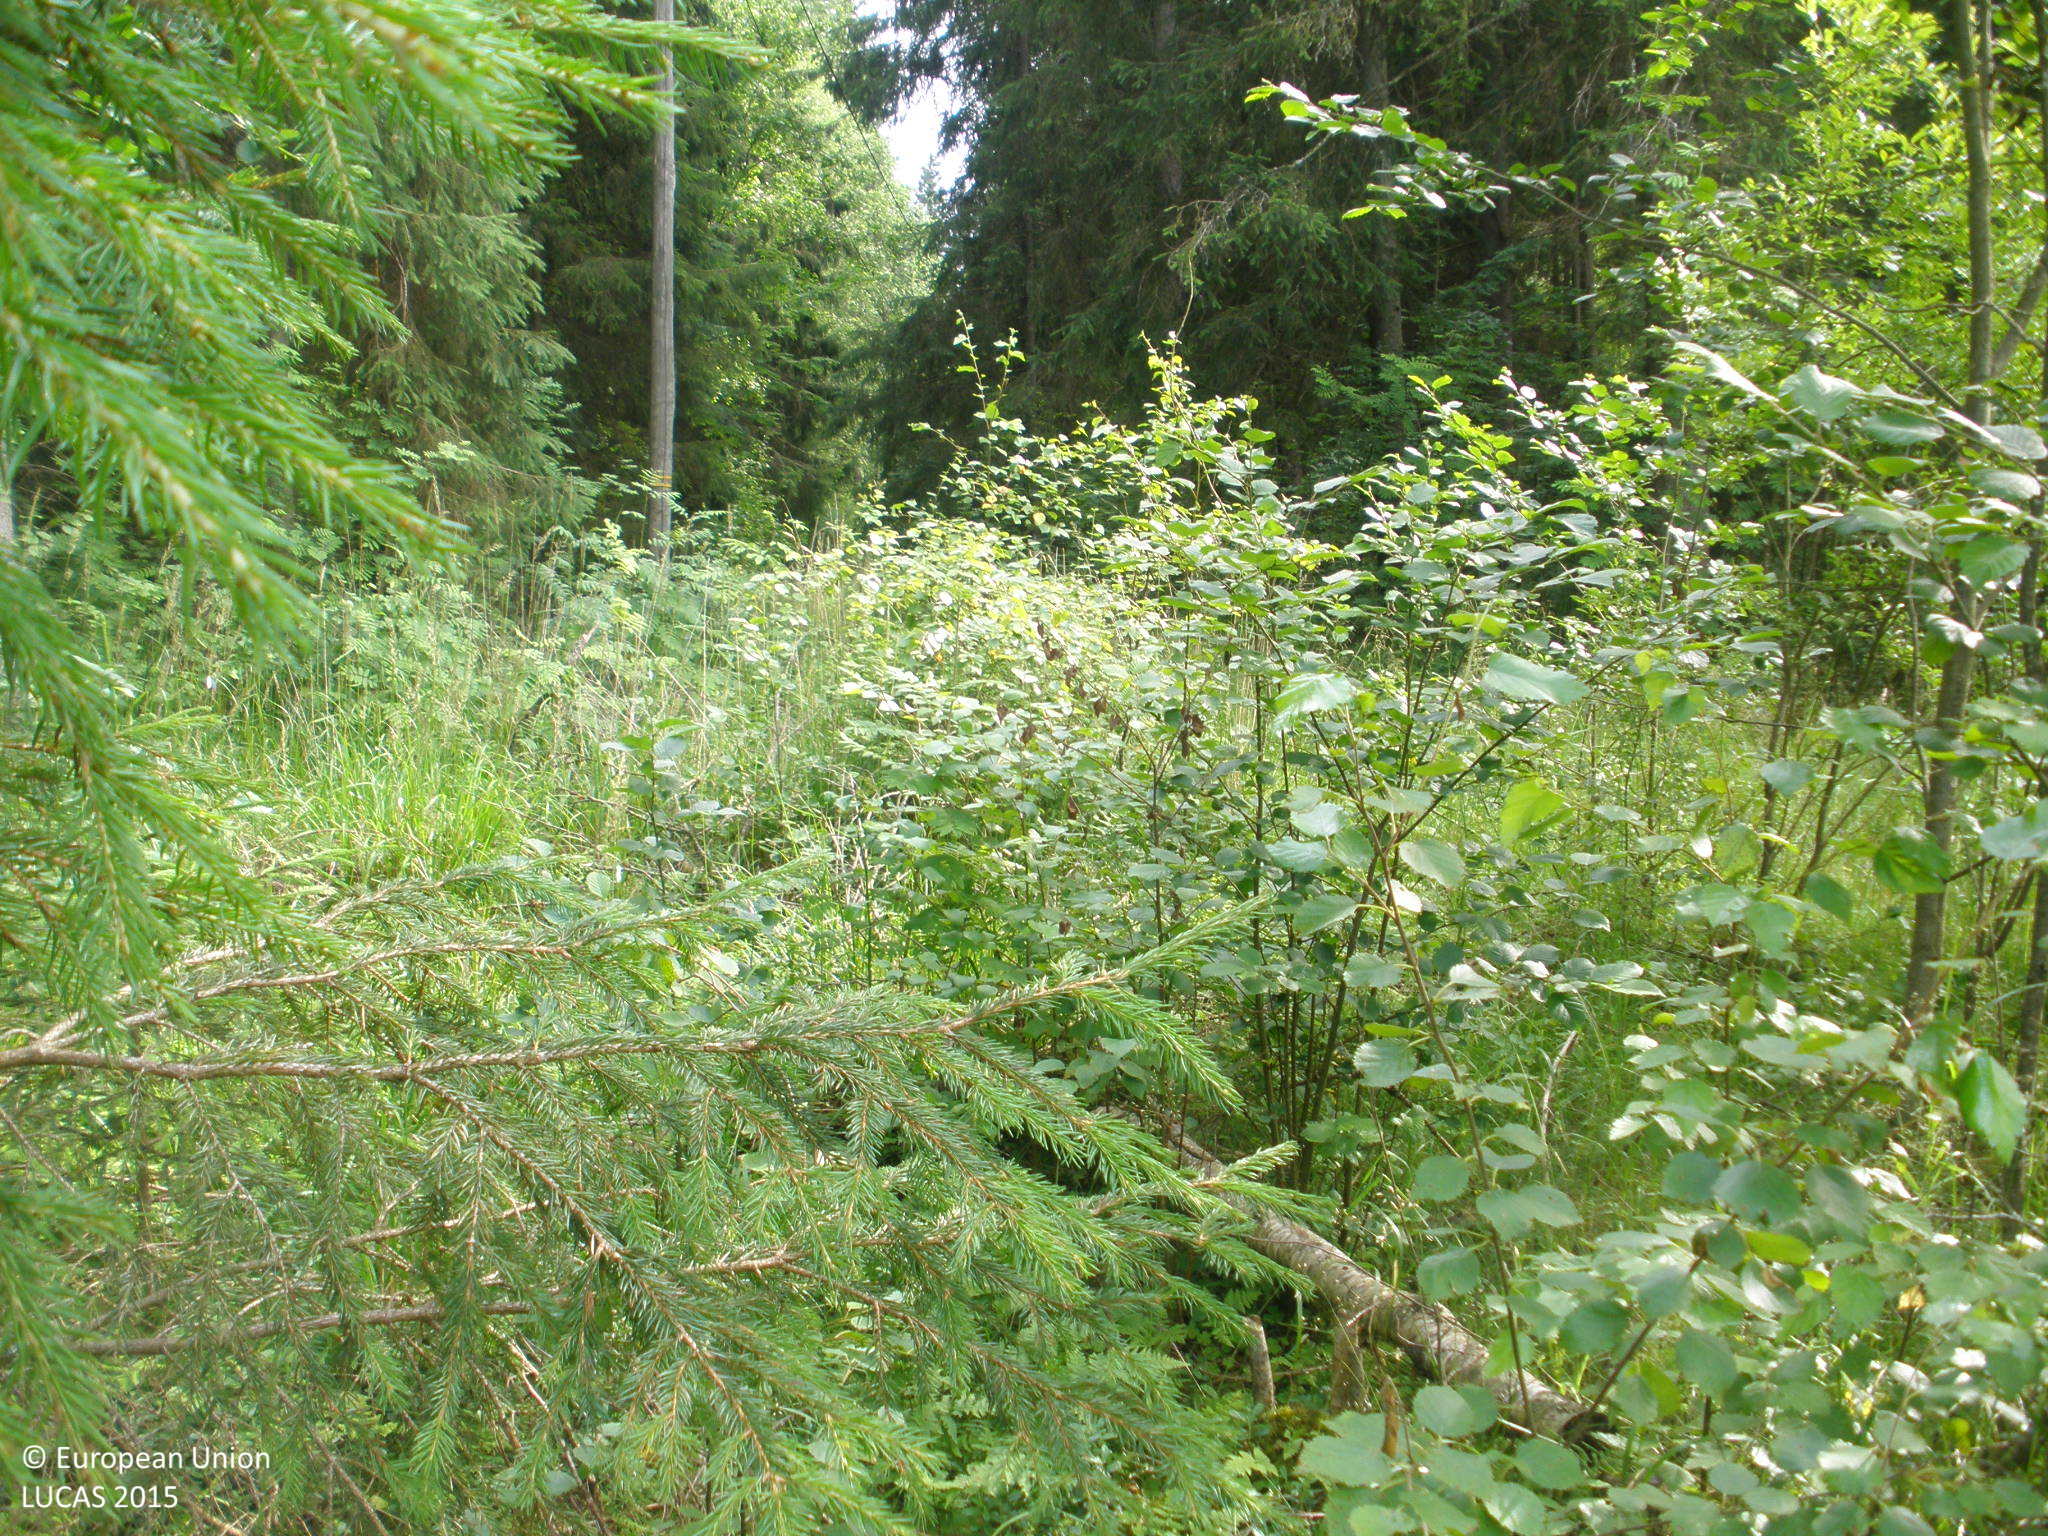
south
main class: Grassland
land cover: Grassland without tree/shrub cover
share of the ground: > 75 %
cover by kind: herbaceous plants 100 %
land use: Agriculture (excluding fallow land and kitchen gardens)
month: July
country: FI
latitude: 61.1326
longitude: 25.2134
